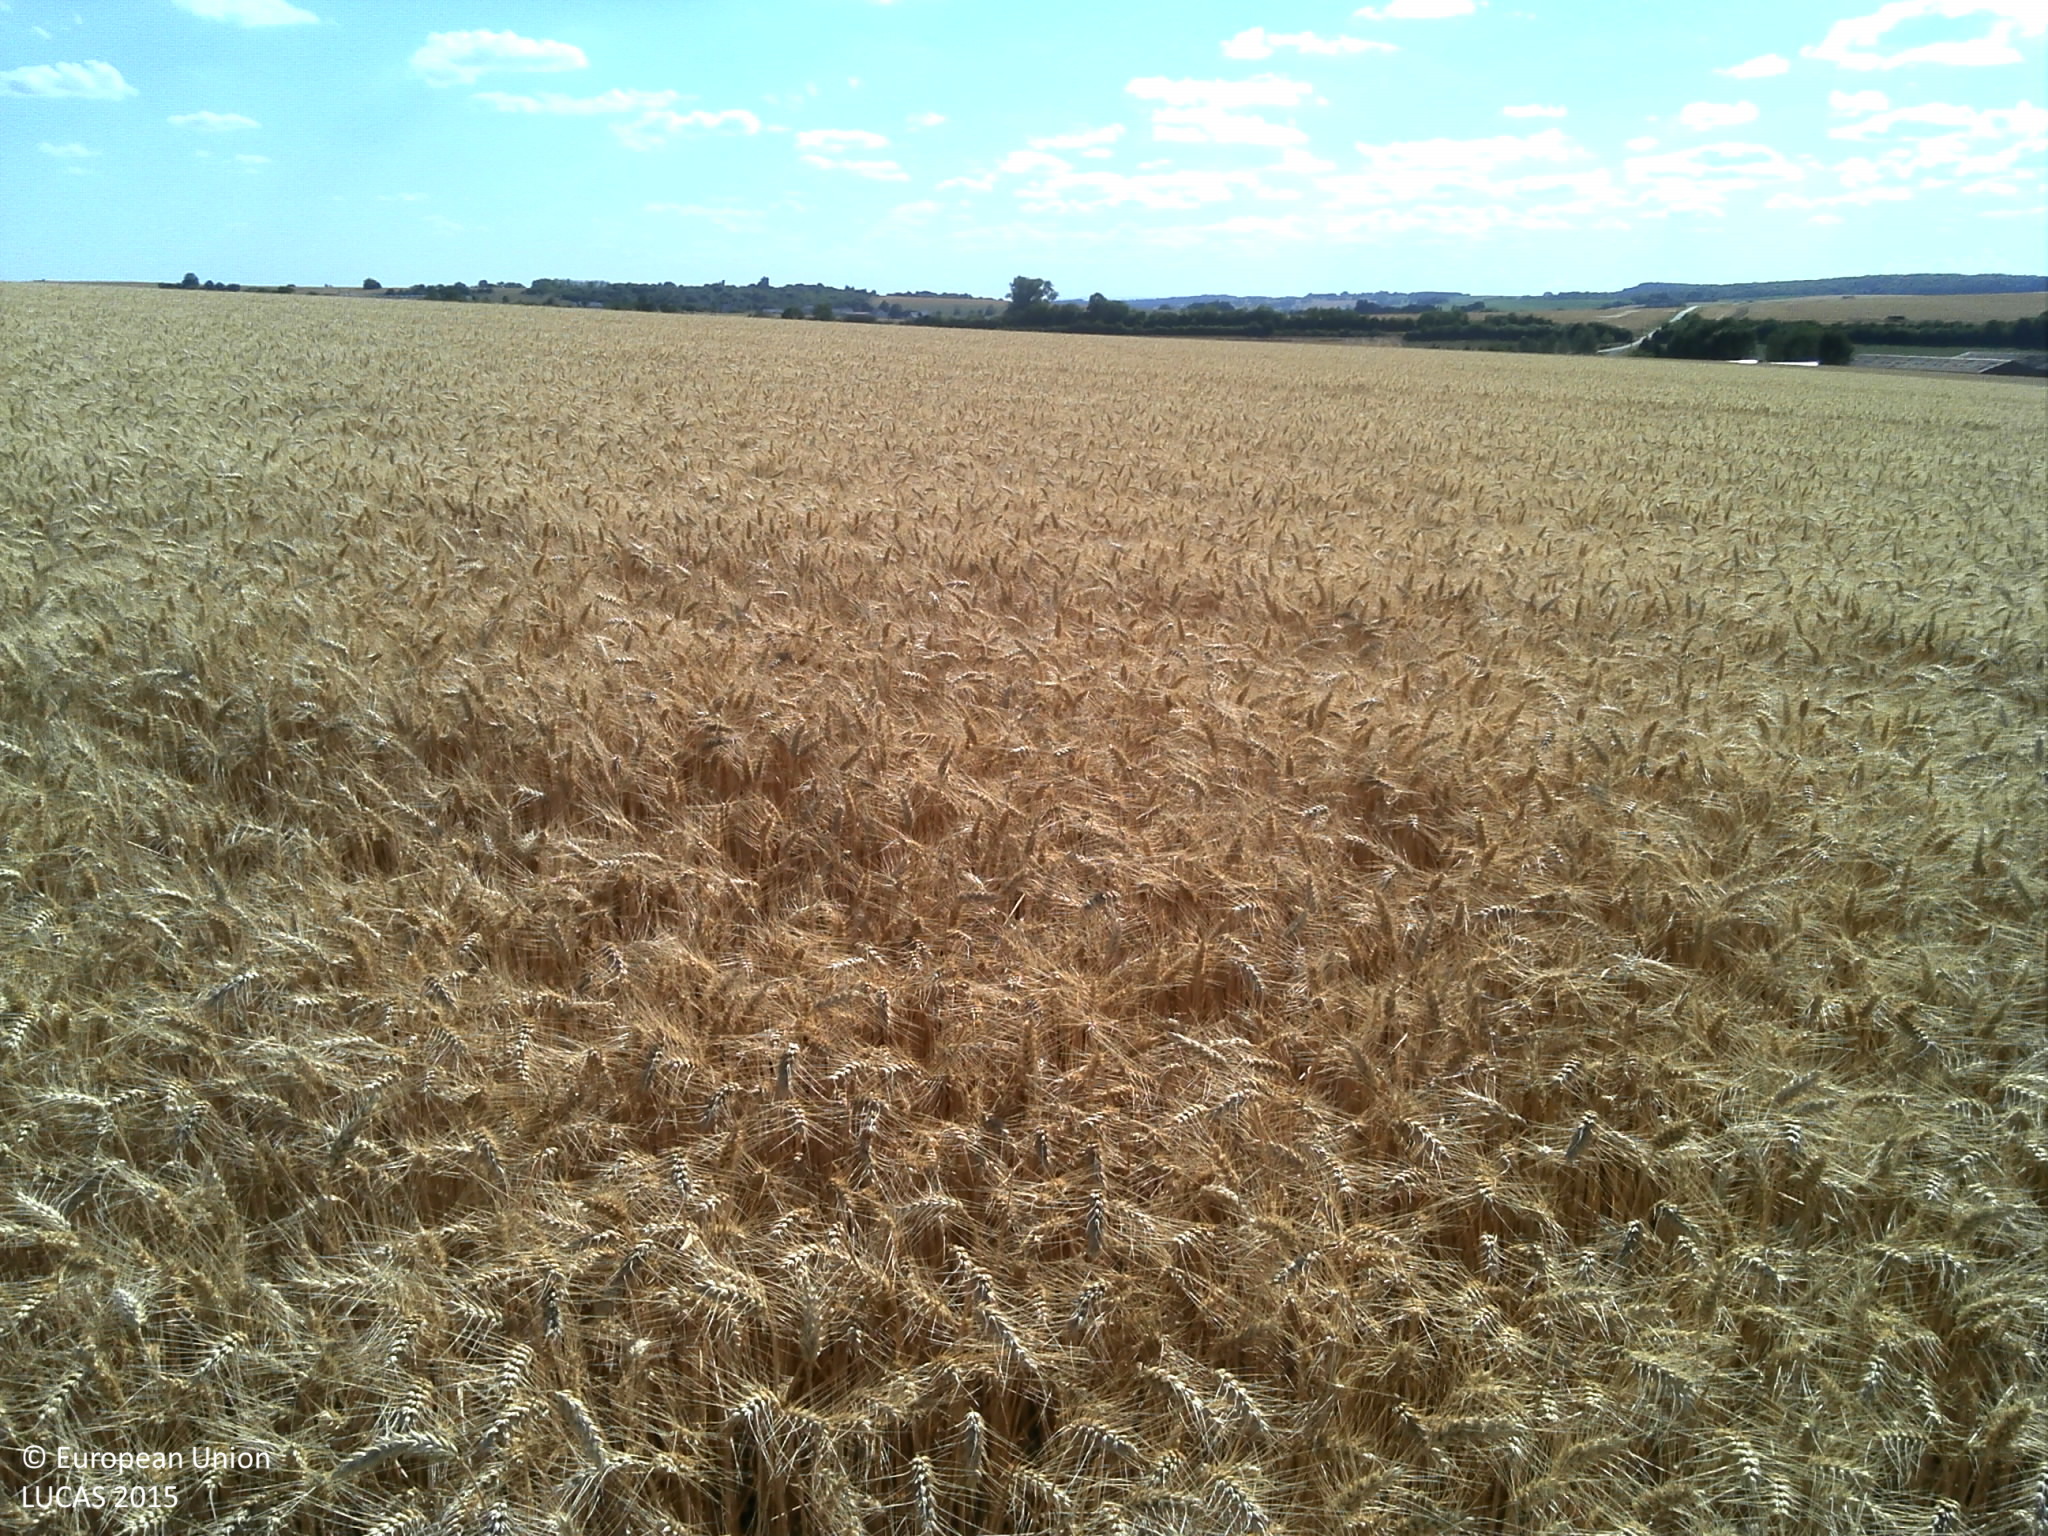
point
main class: Cropland
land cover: Common wheat
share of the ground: > 75 %
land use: Agriculture (excluding fallow land and kitchen gardens)
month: July
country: FR
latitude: 49.0713
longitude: 7.2491
